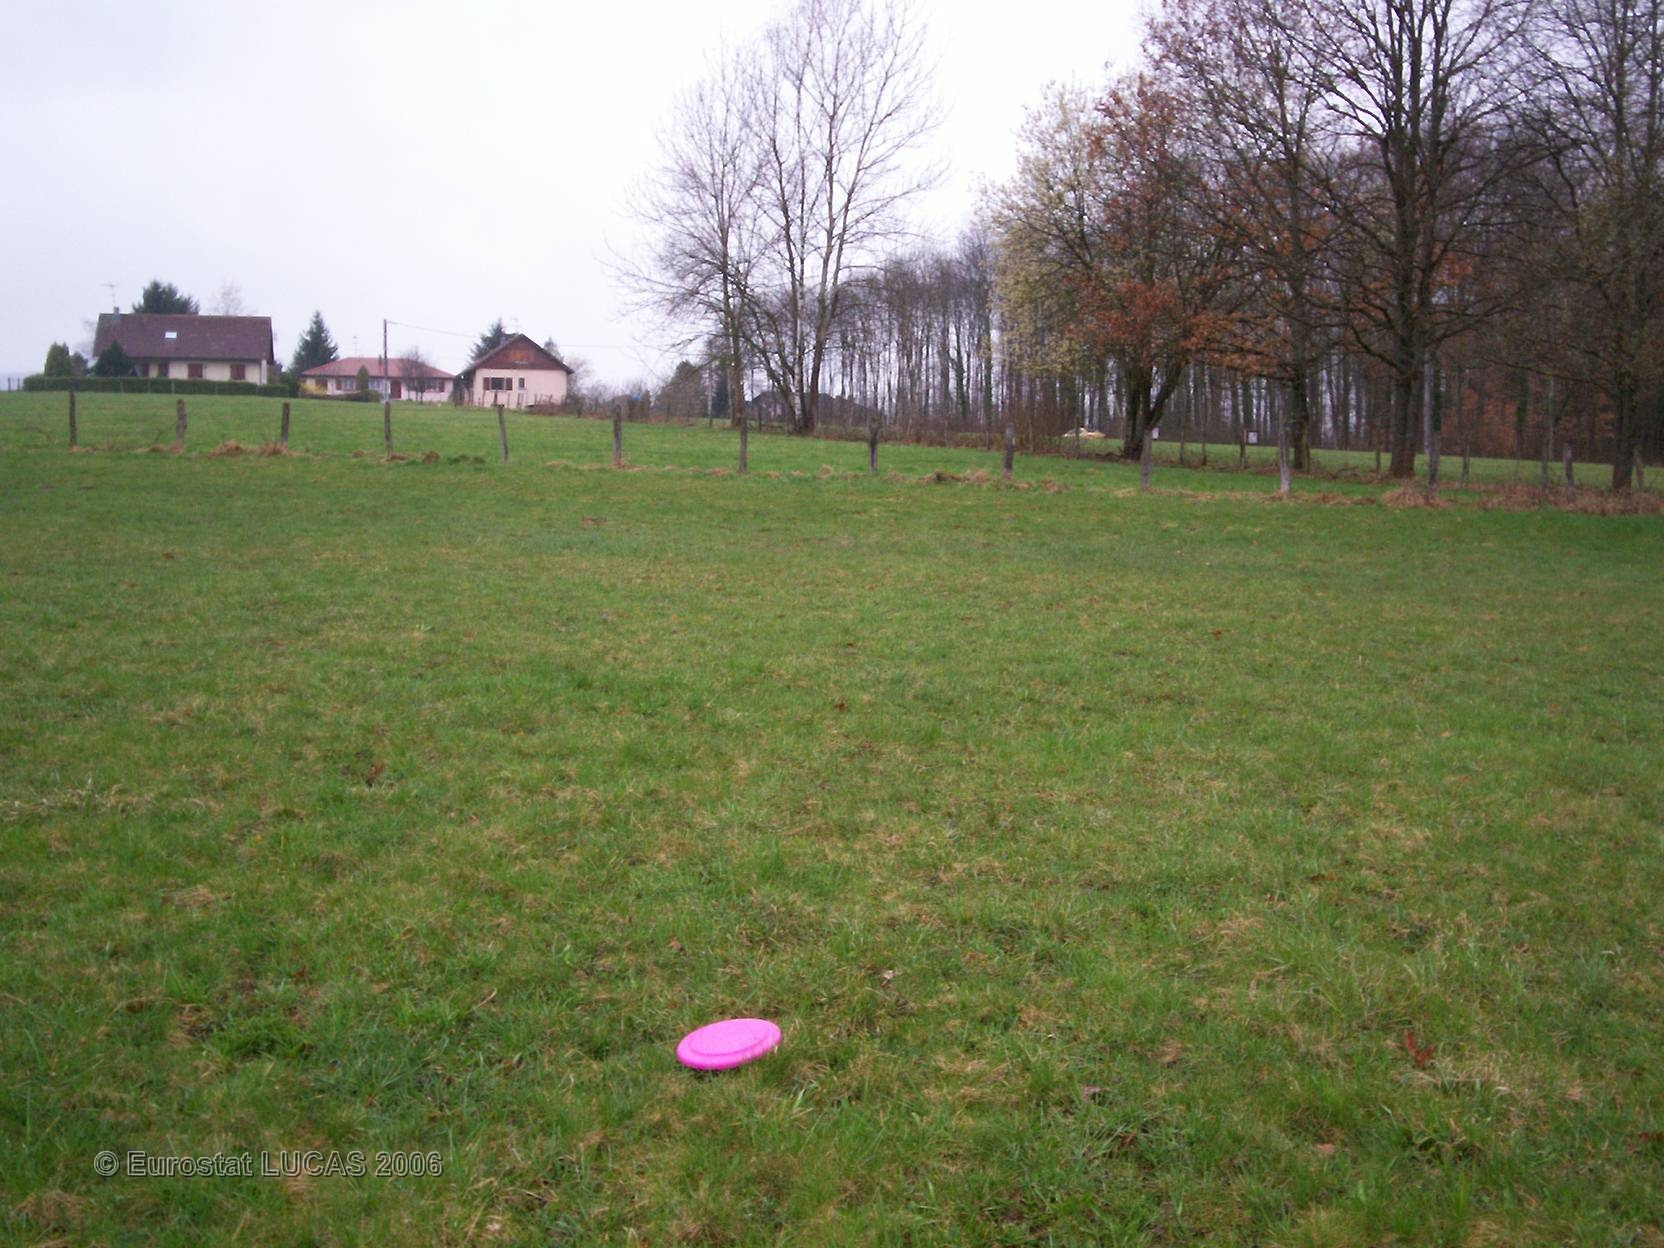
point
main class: Grassland
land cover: Grassland without tree/shrub cover
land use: Agriculture (excluding fallow land and kitchen gardens)
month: April
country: FR
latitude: 47.6186
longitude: 6.7950
